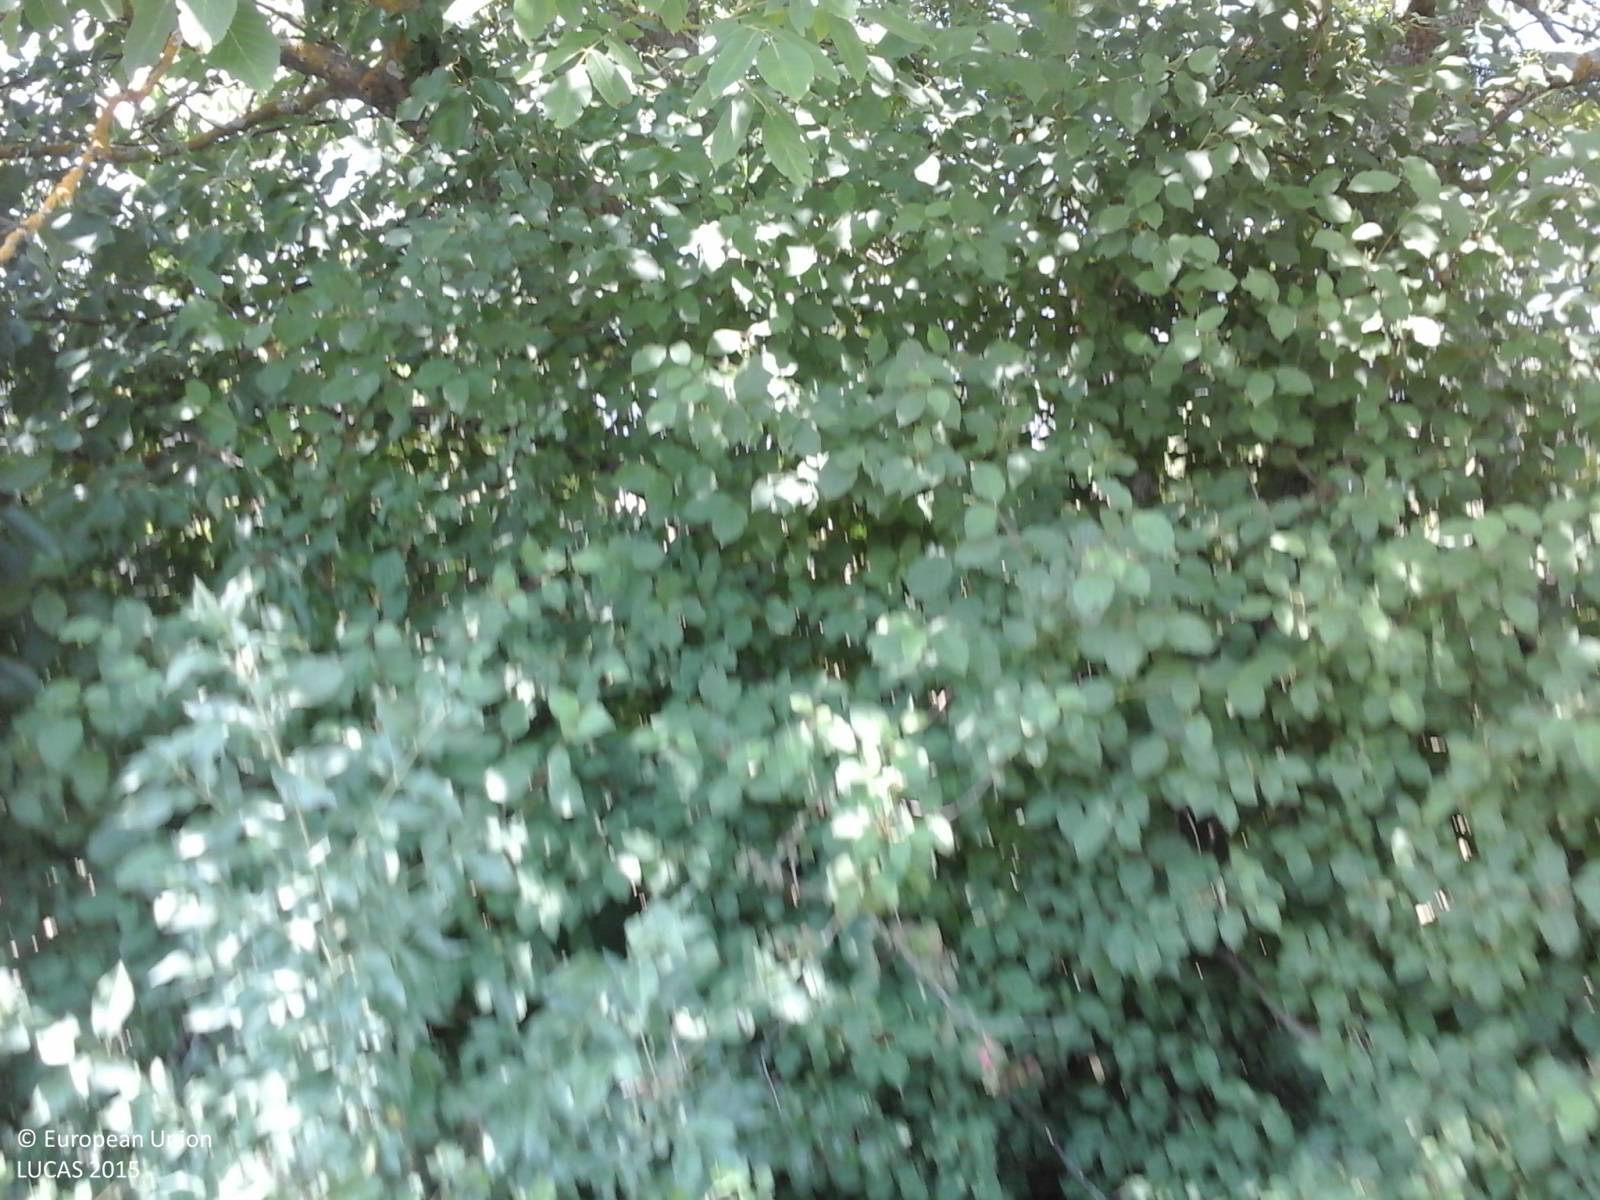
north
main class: Cropland
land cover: Lucerne
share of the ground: > 75 %
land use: Agriculture (excluding fallow land and kitchen gardens)
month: July
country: IT
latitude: 42.4193
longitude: 13.3072
